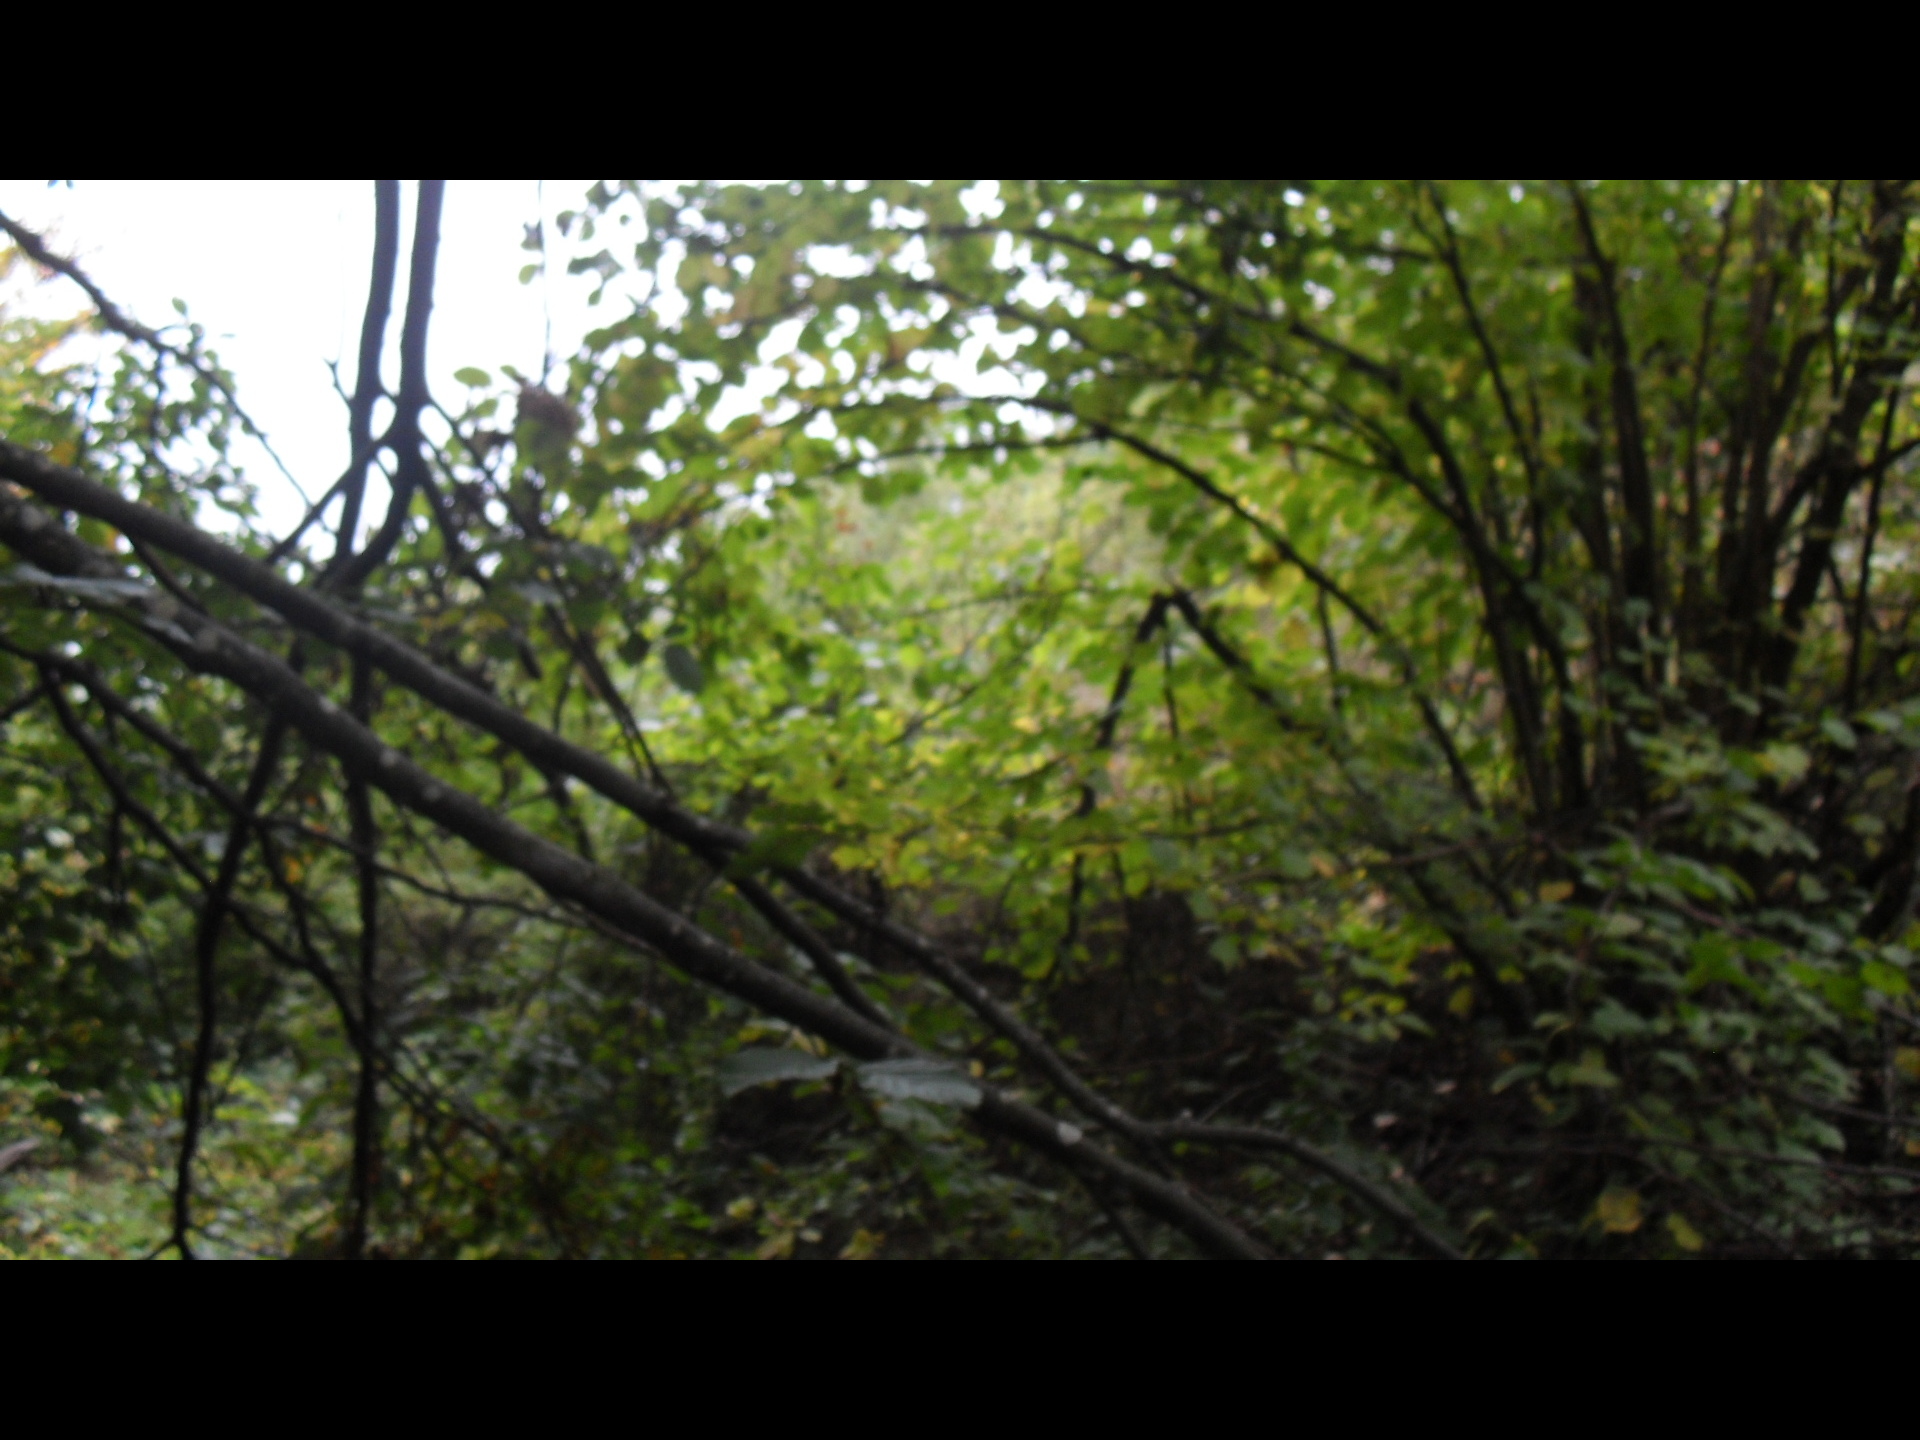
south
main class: Woodland
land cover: Broadleaved woodland
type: mesophytic deciduous forest
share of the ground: > 75 %
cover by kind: broadleaved forest trees 95 %, shrubs 5 %
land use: Forestry
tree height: > 5 m
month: October
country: BG
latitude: 43.5109
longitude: 22.5618
